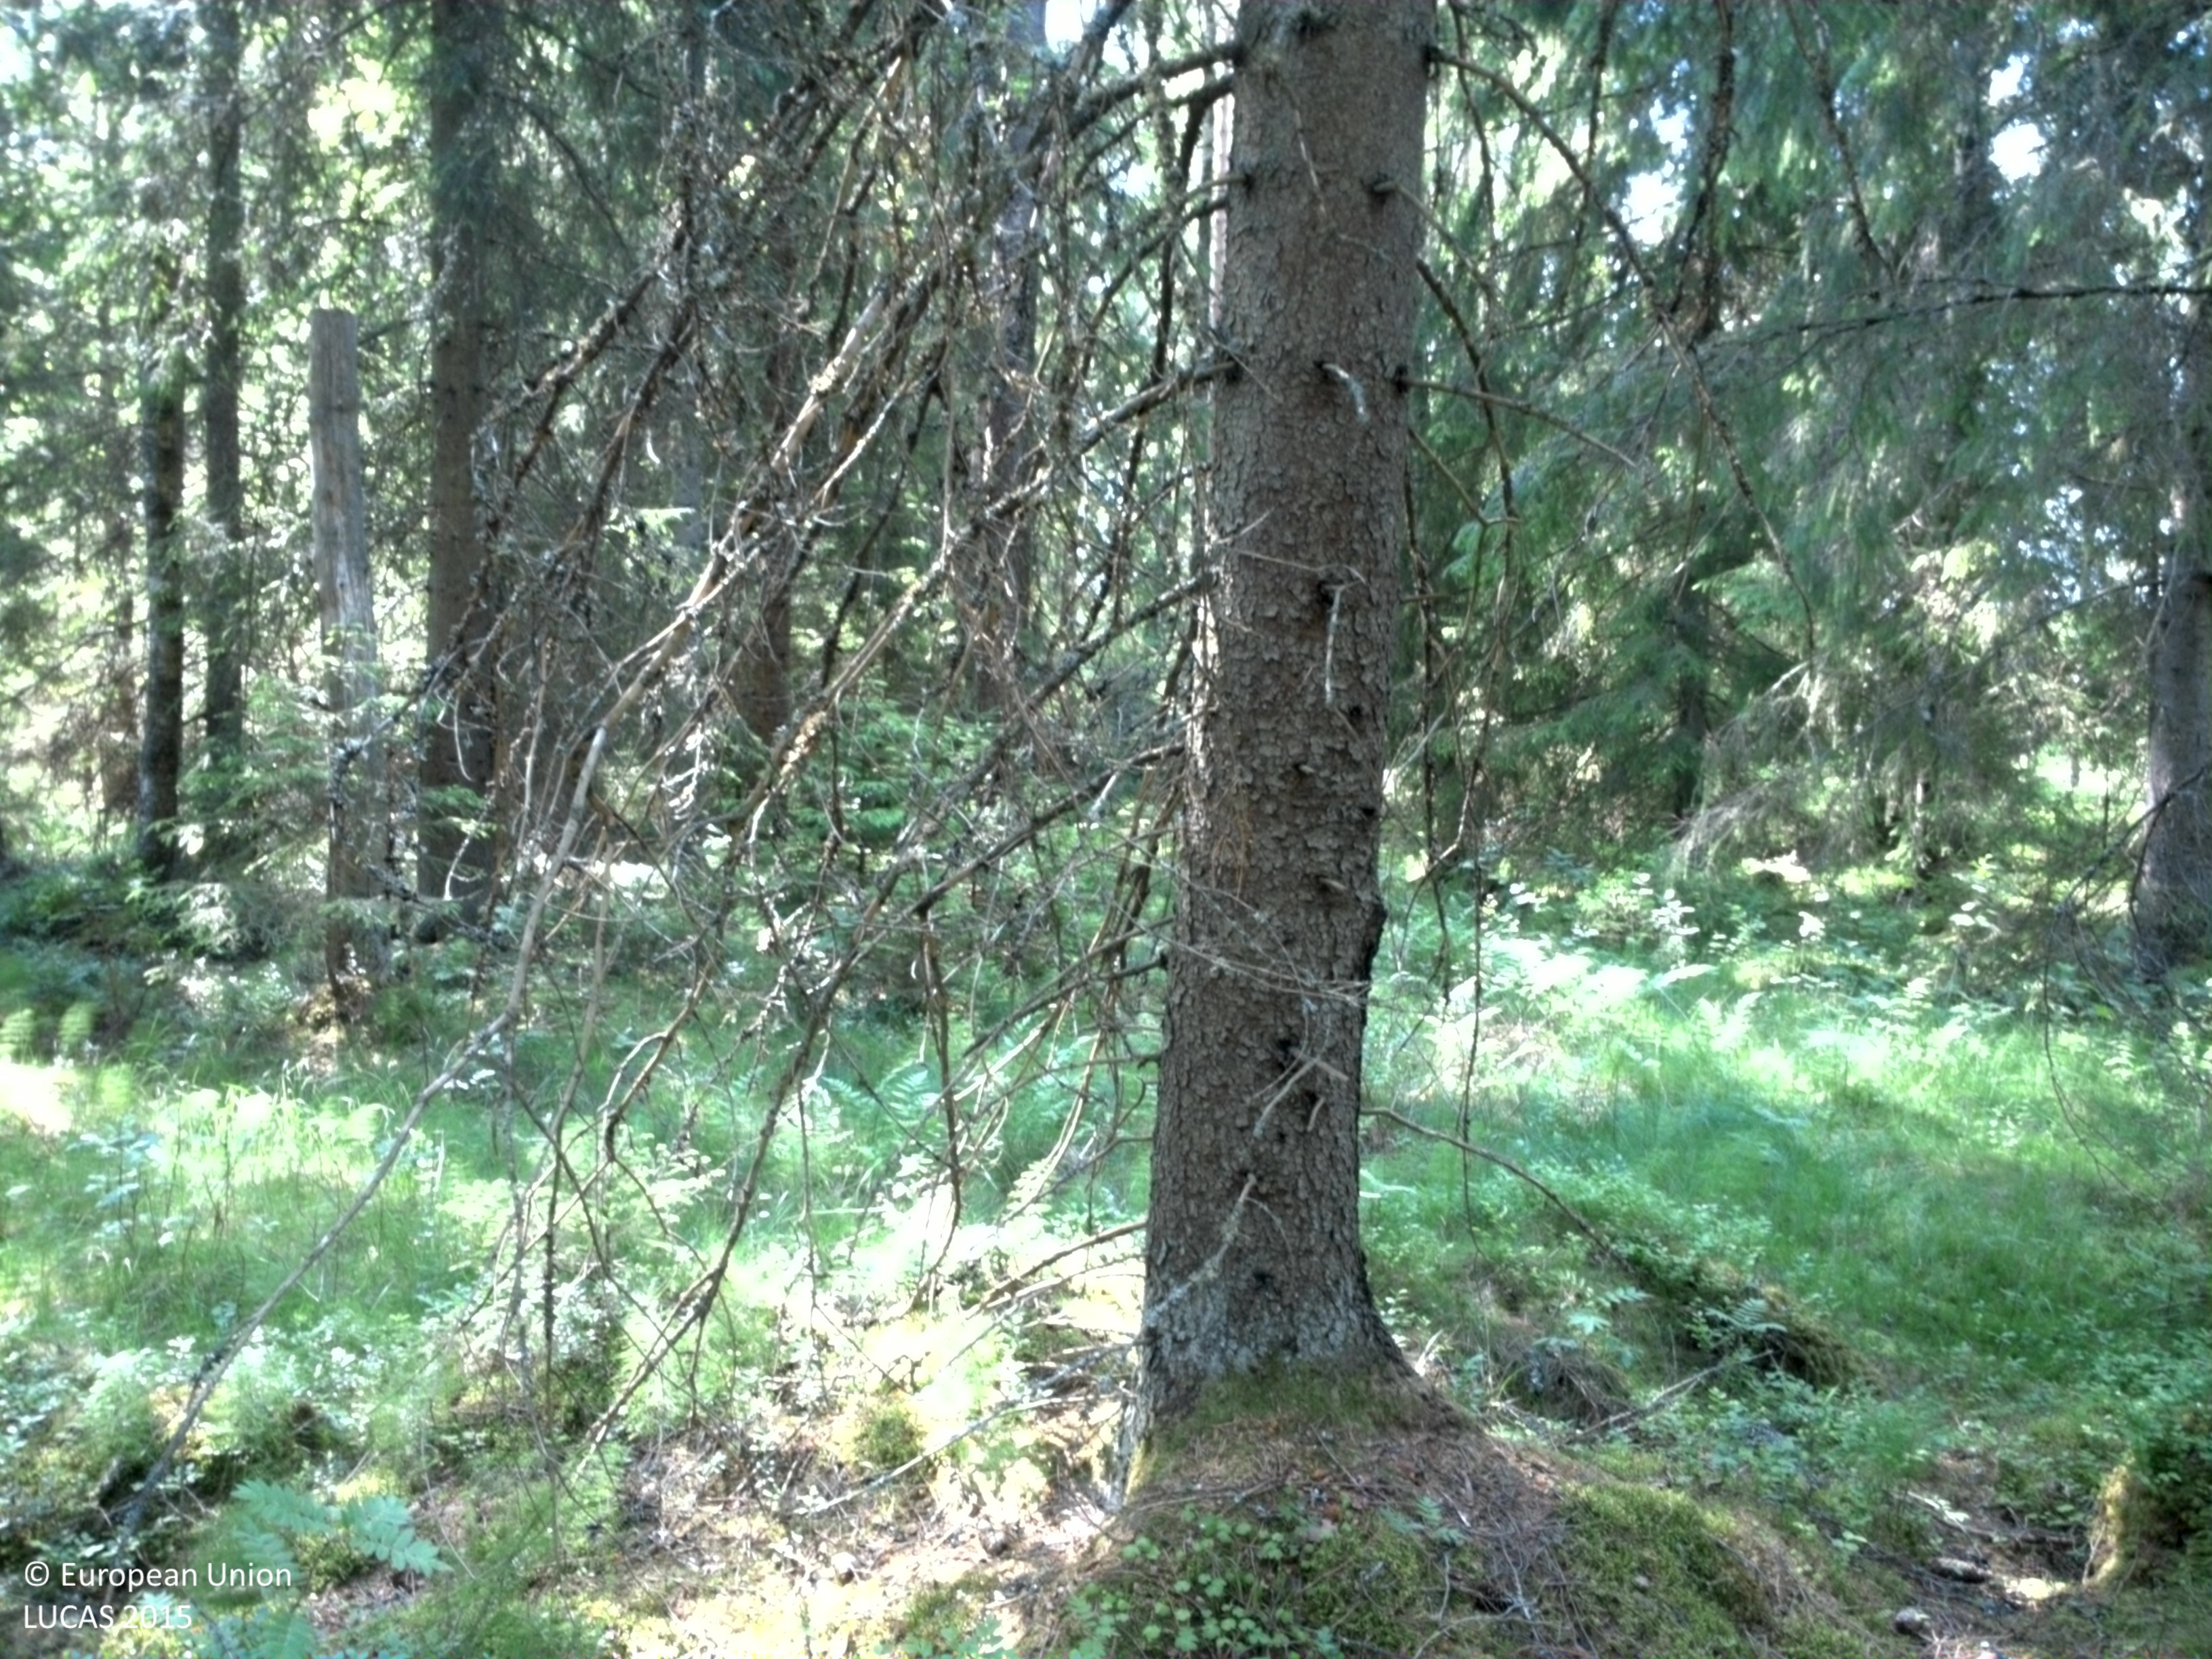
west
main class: Woodland
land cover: Spruce dominated coniferous woodland
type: boreal forest
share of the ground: 50 - 75 %
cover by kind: coniferous forest trees 70 %, shrubs 10 %, lichens and mosses 10 %, broadleaved forest trees 5 %, herbaceous plants 5 %
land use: Forestry
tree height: > 5 m
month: July
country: SE
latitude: 57.6219
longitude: 13.9299
